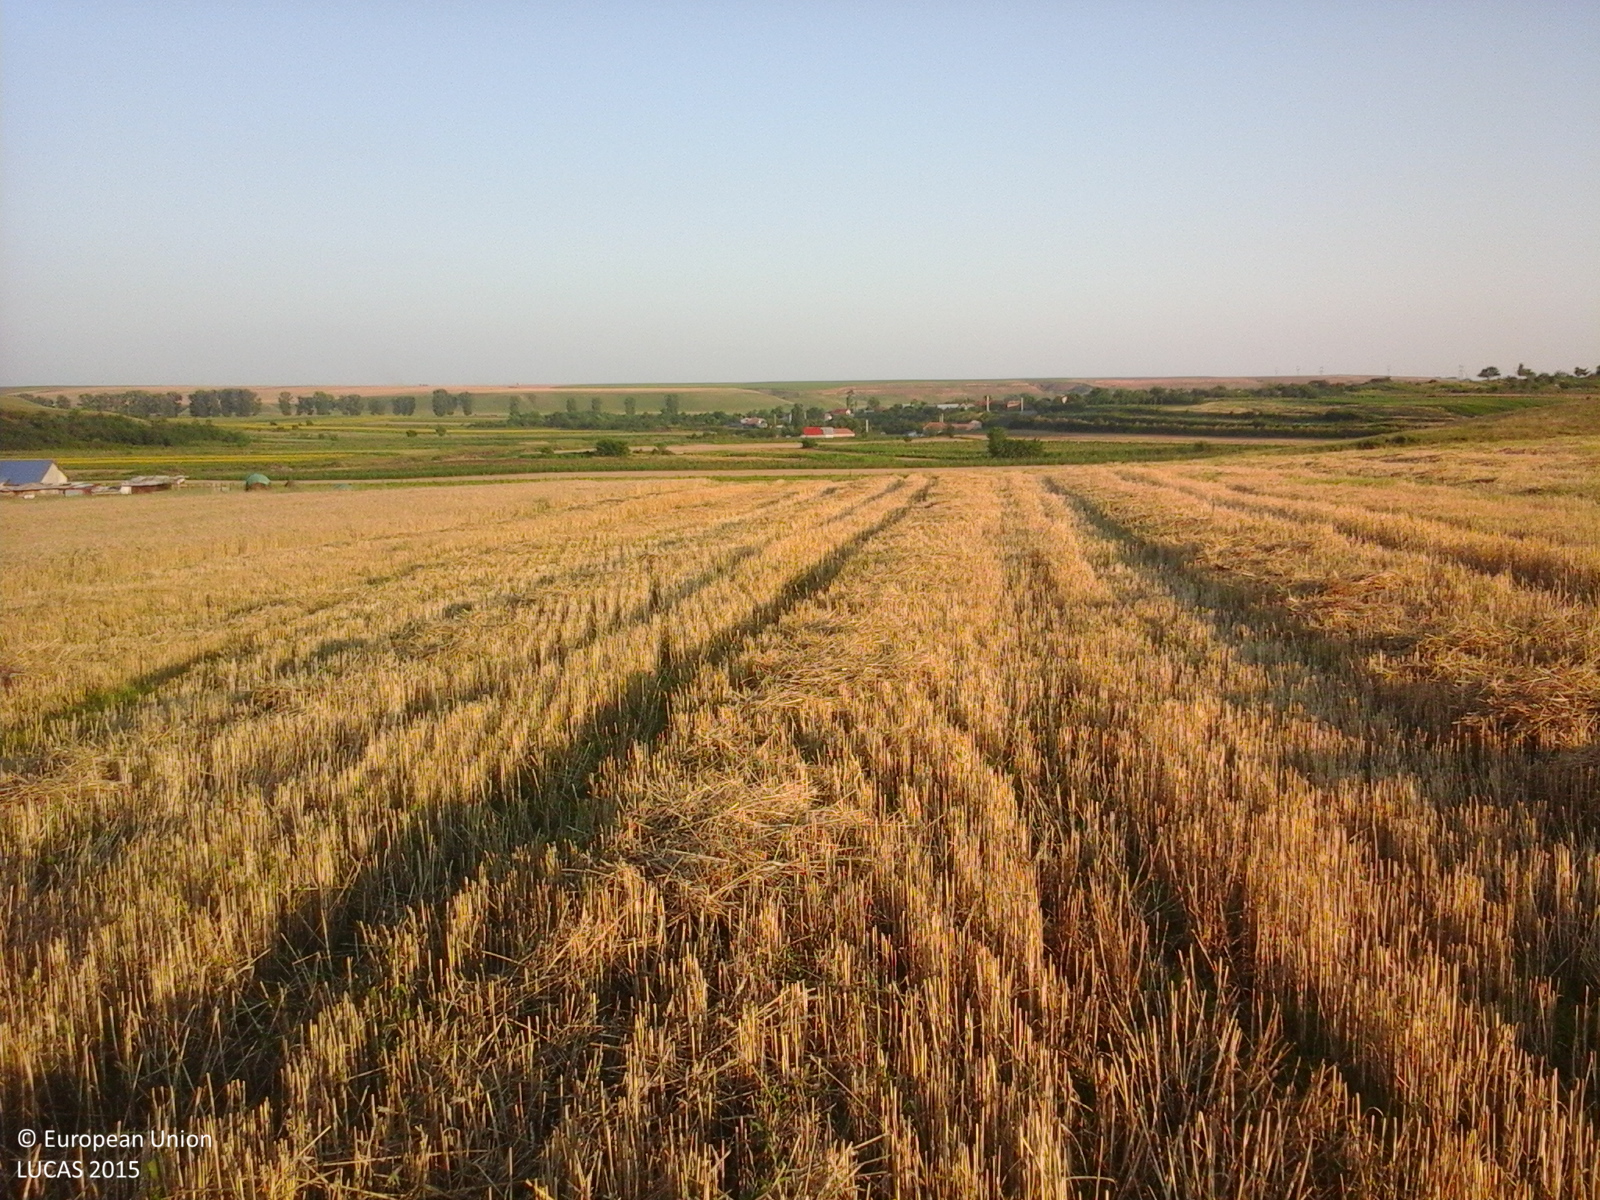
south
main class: Cropland
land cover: Common wheat
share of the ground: 50 - 75 %
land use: Agriculture (excluding fallow land and kitchen gardens)
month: July
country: RO
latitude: 44.2611
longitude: 24.4860
